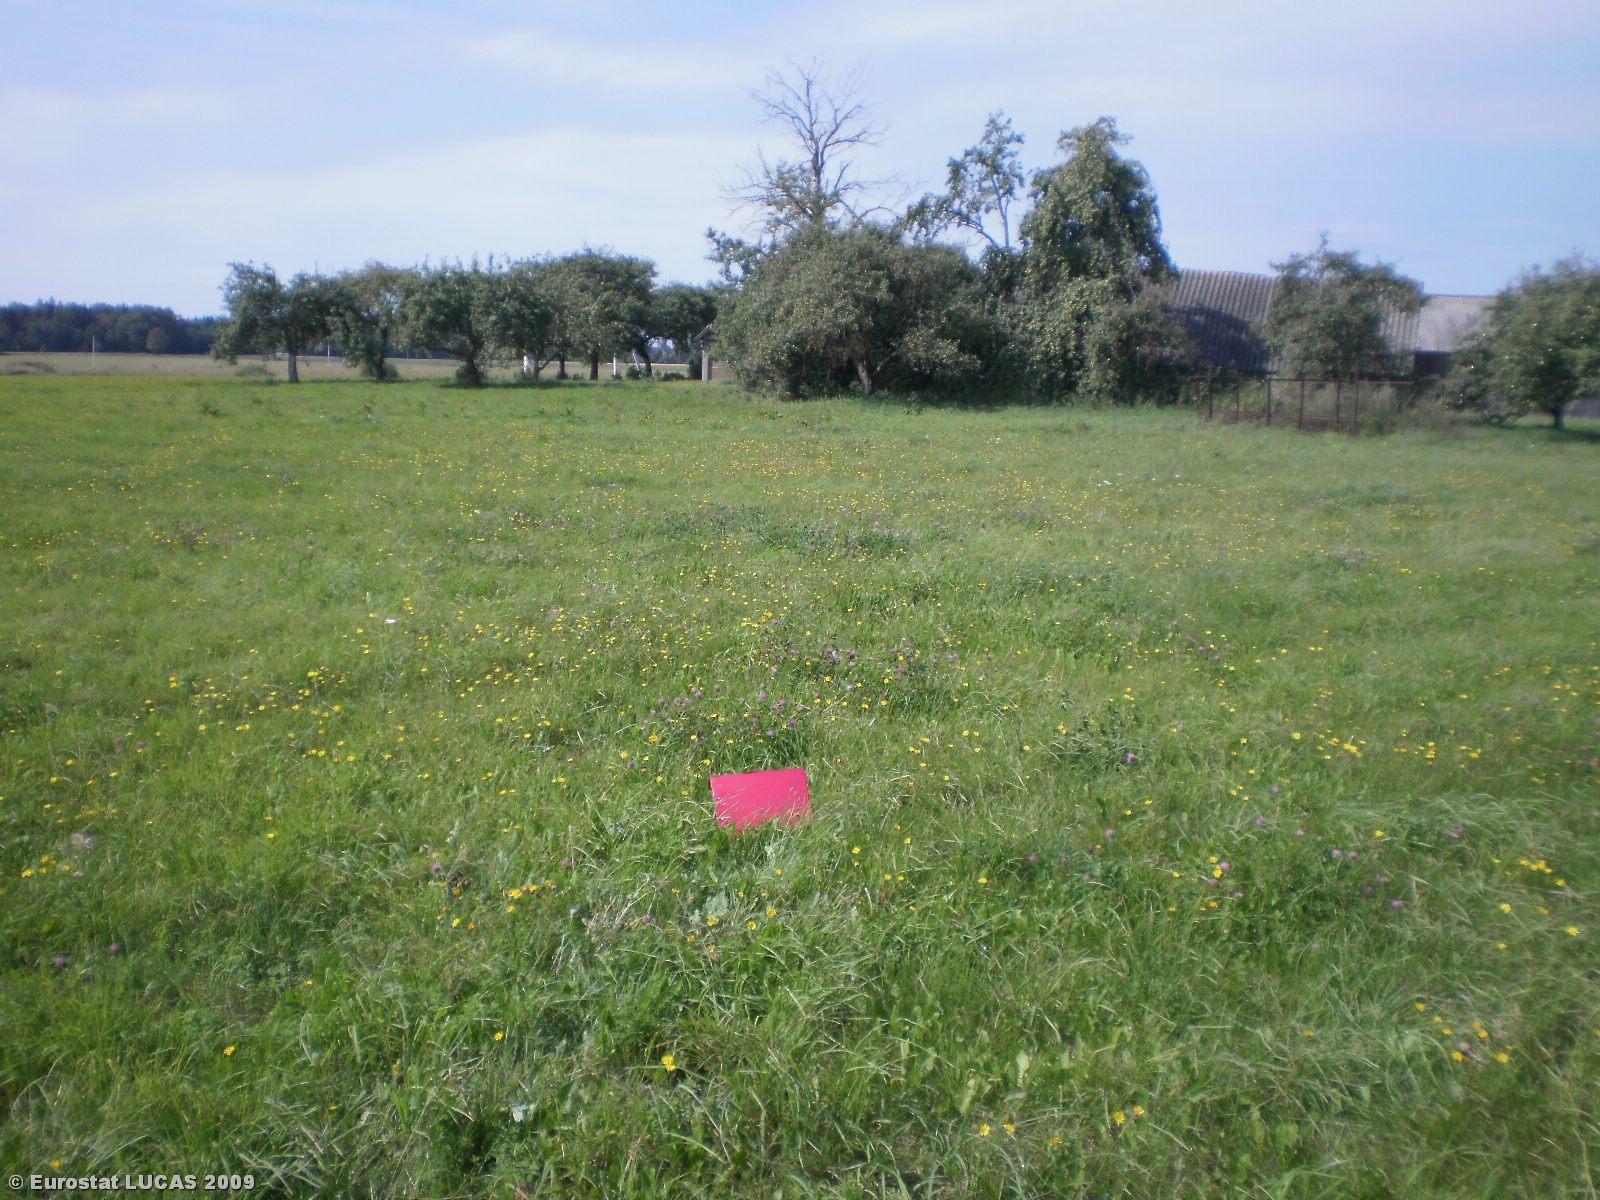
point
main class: Grassland
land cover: Grassland without tree/shrub cover
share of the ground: > 75 %
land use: Agriculture (excluding fallow land and kitchen gardens)
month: August
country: LT
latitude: 55.0648
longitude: 24.8119
